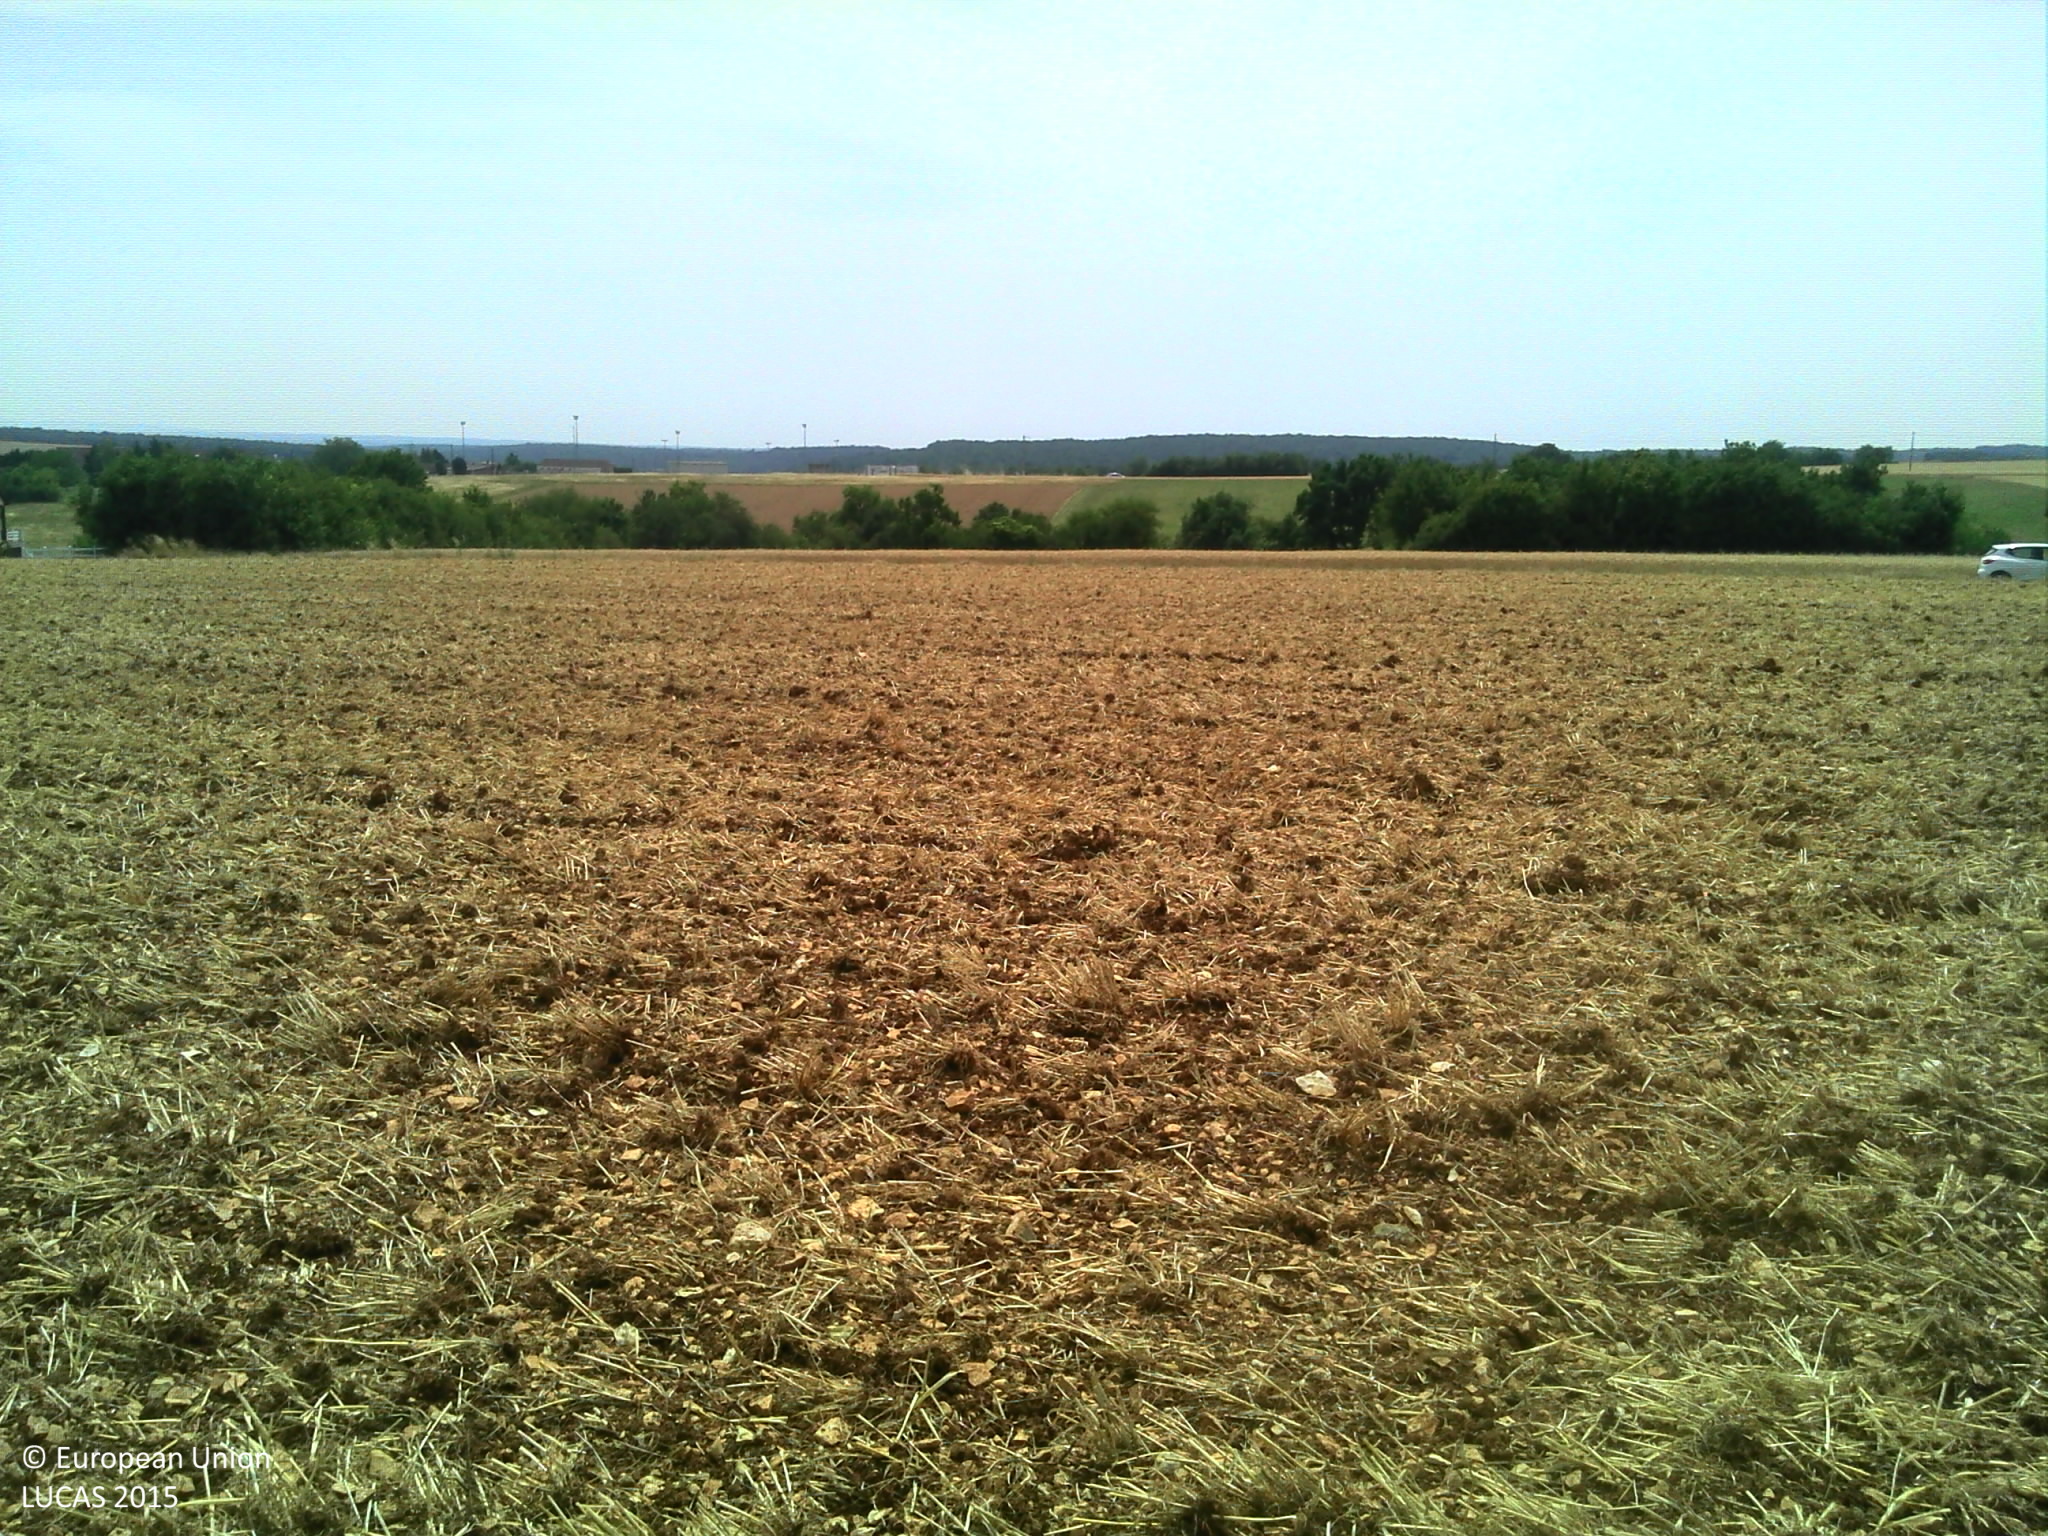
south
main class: Cropland
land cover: Barley
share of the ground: > 75 %
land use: Agriculture (excluding fallow land and kitchen gardens)
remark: Harvested field
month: July
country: FR
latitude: 47.6158
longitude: 3.4900
